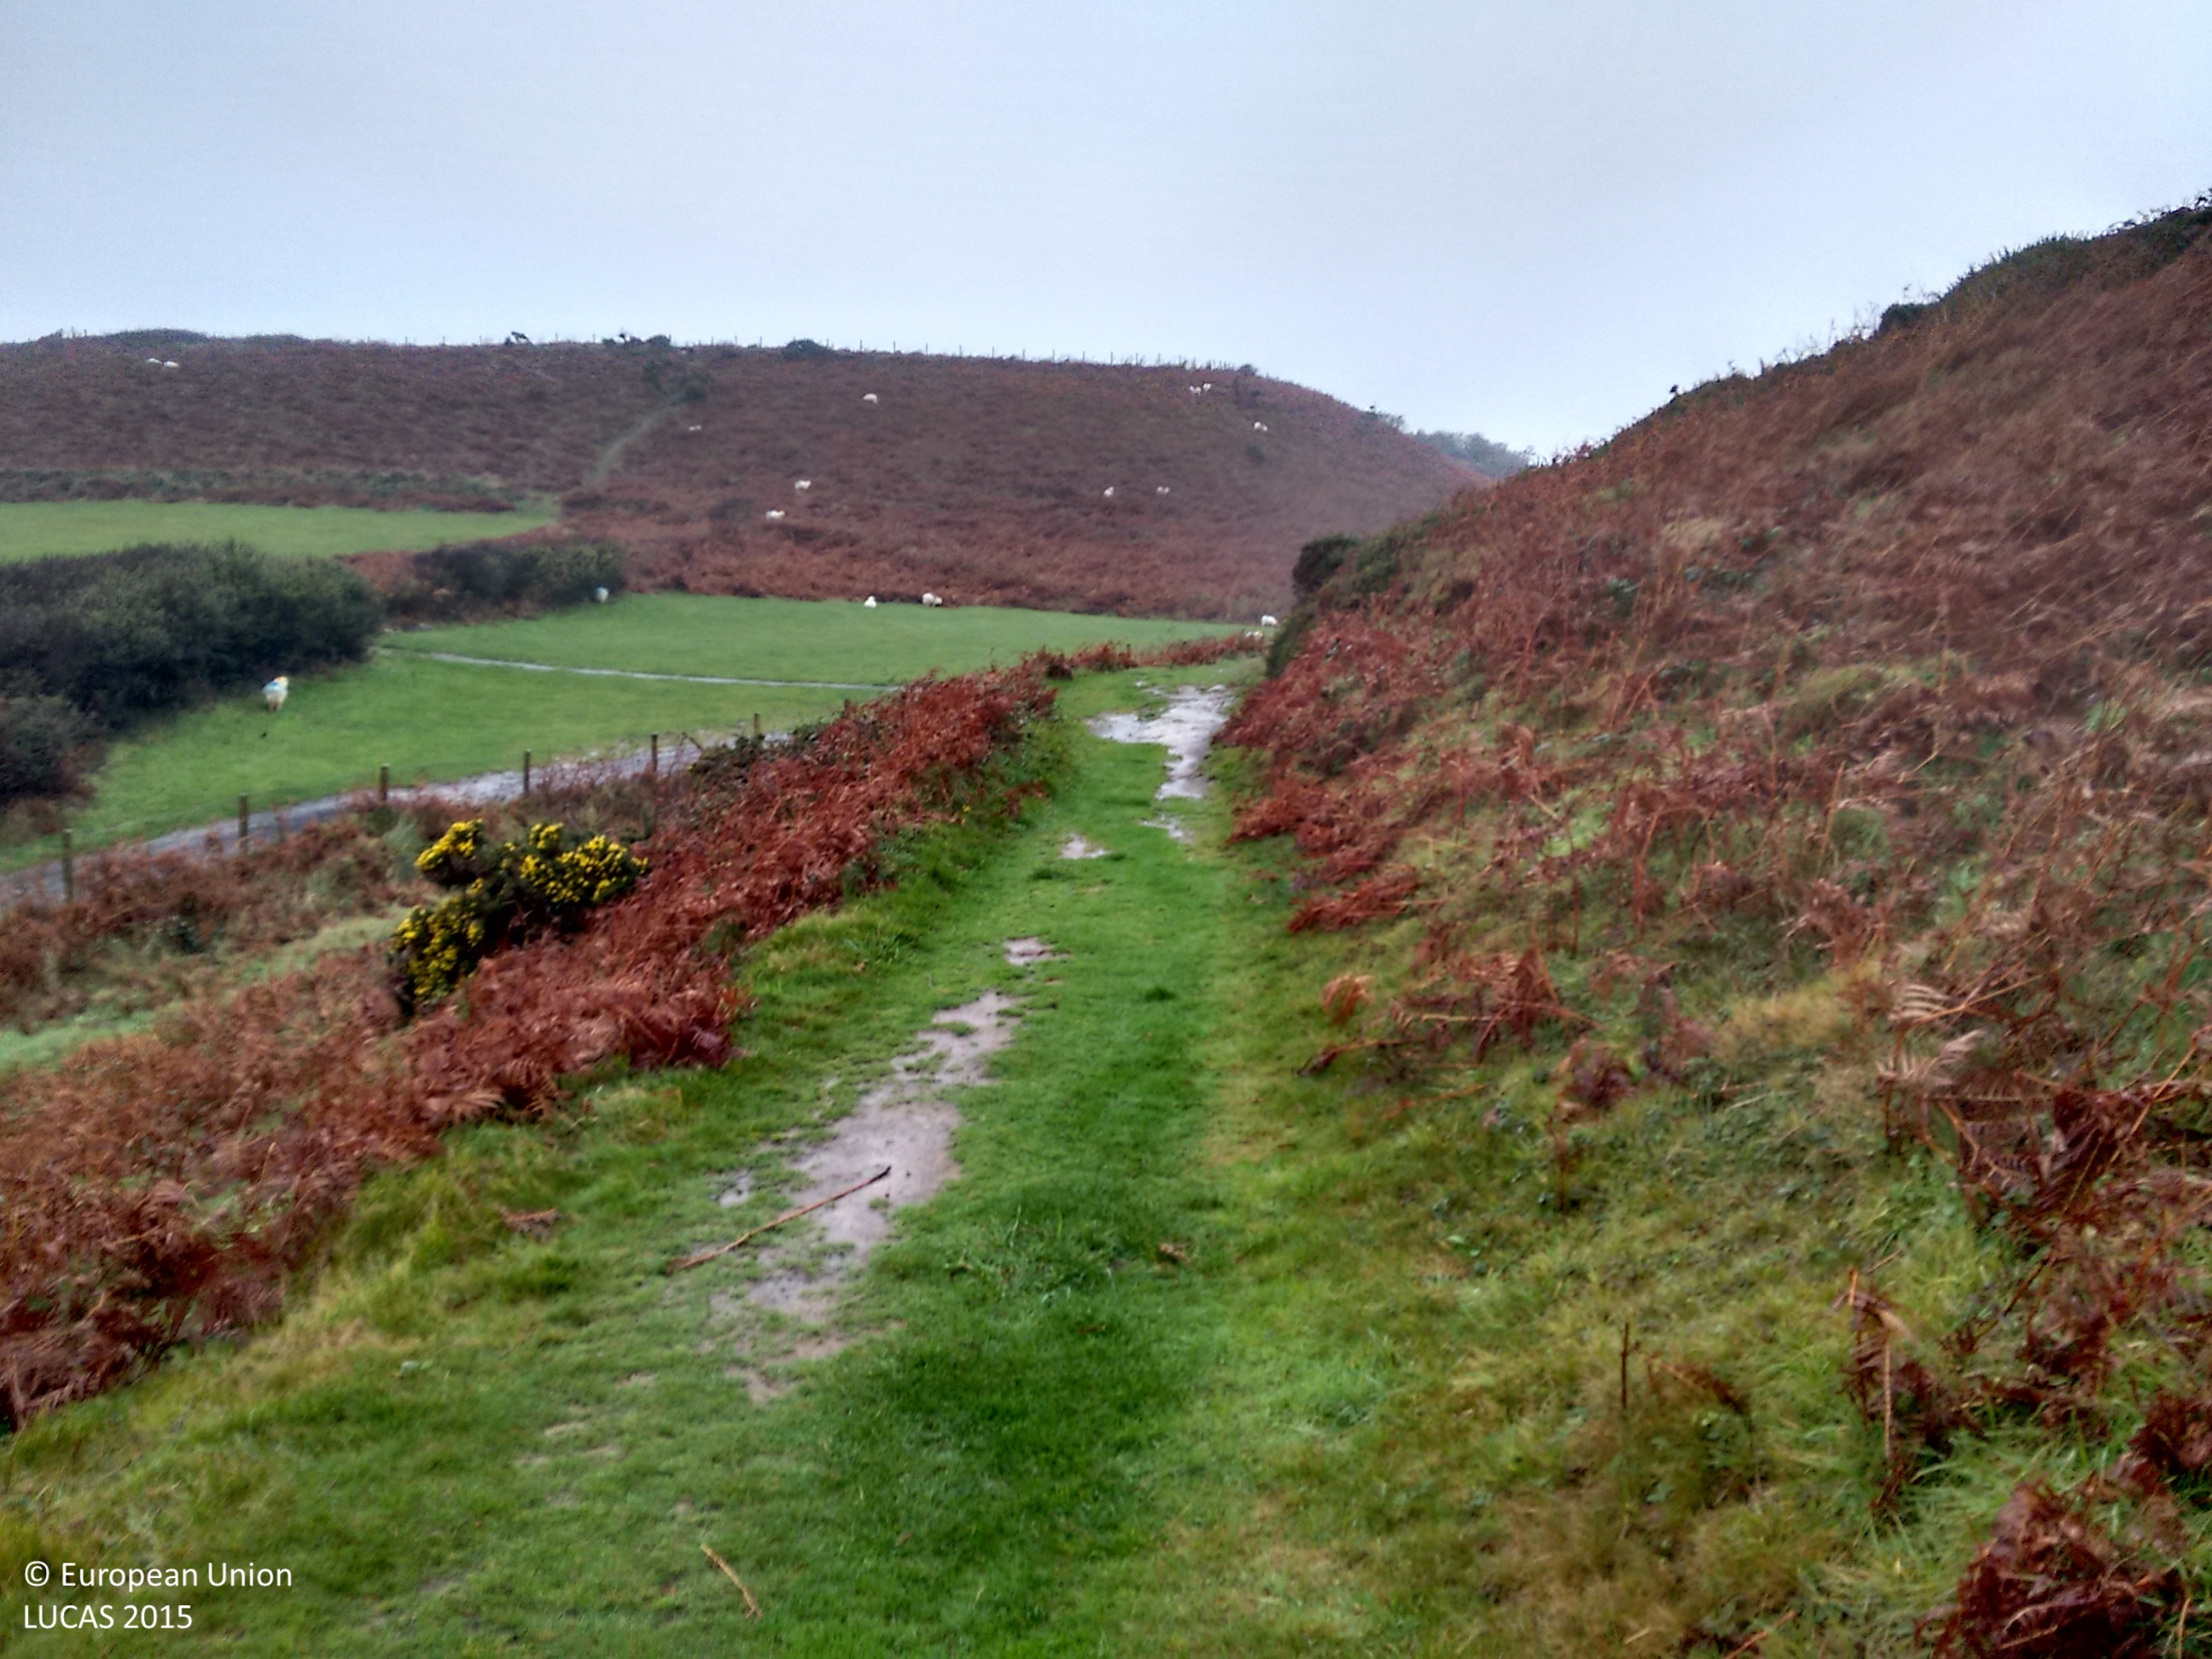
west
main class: Shrubland
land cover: Shrubland without tree cover
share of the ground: > 75 %
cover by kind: shrubs 80 %, herbaceous plants 20 %
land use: Agriculture (excluding fallow land and kitchen gardens)
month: November
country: GB
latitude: 52.7962
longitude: -4.5061
